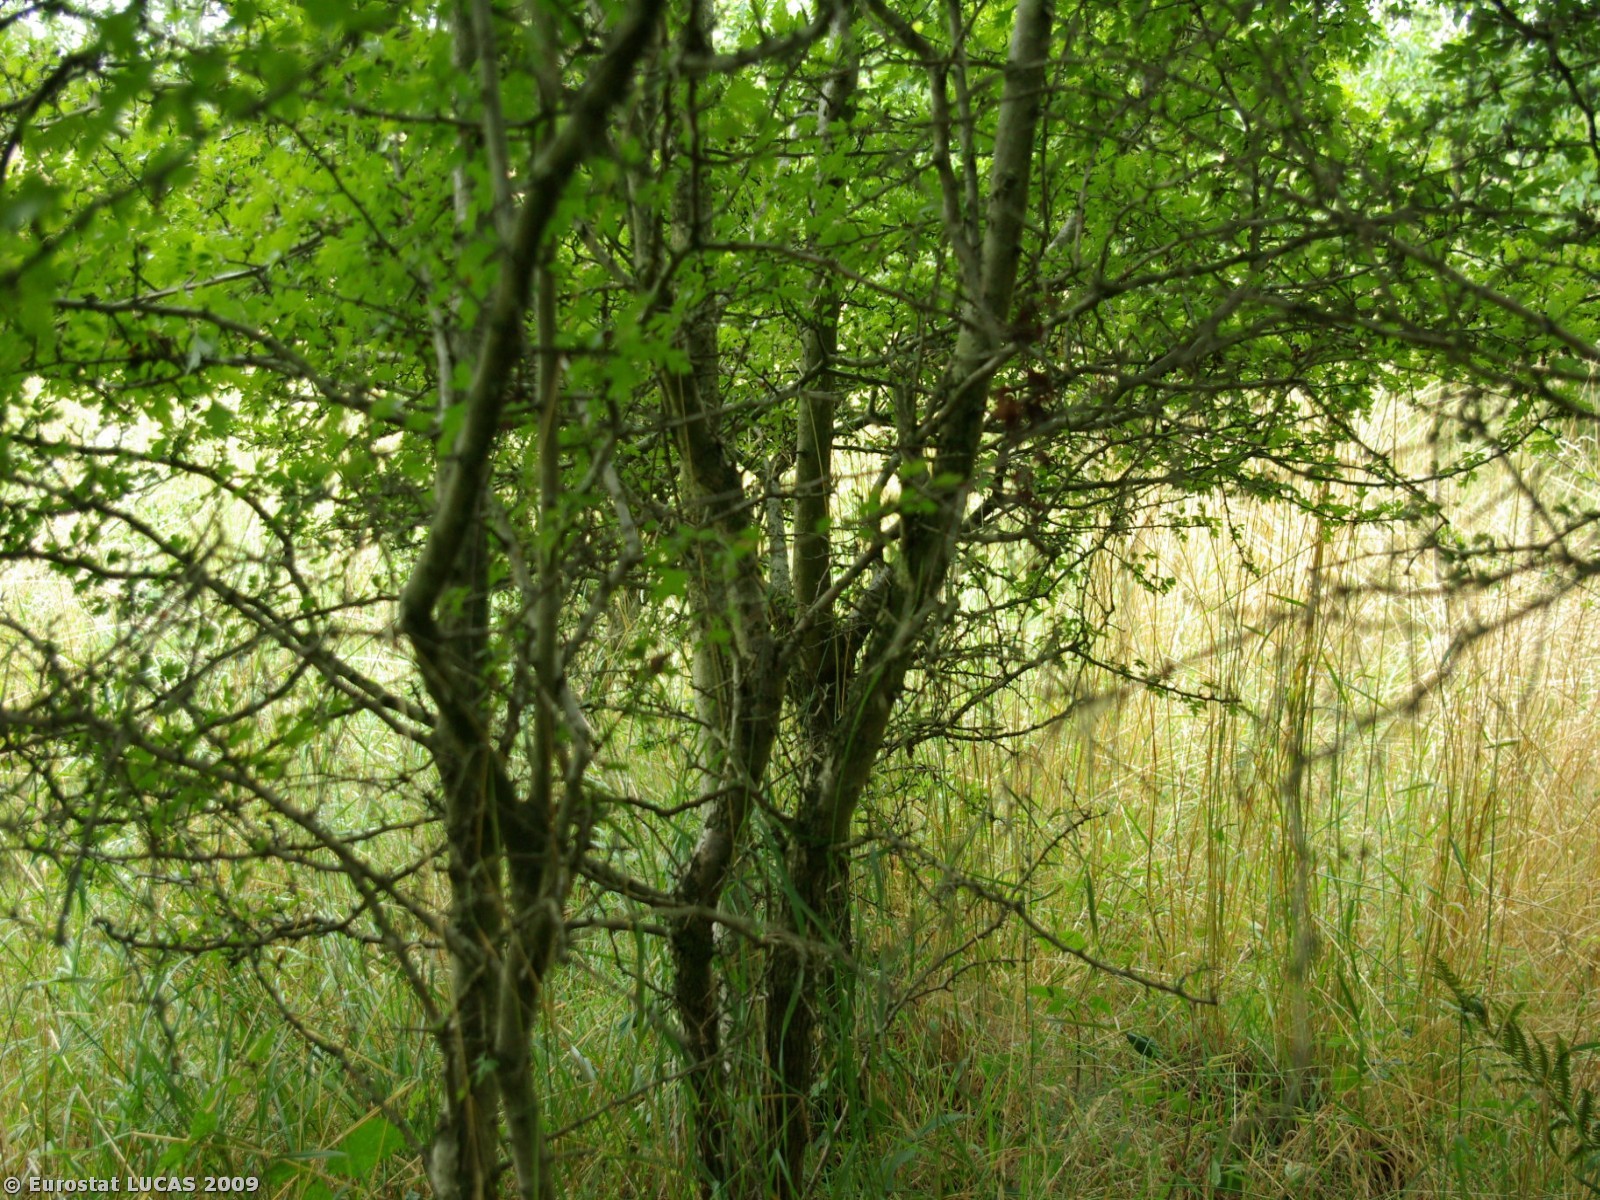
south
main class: Woodland
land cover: Broadleaved woodland
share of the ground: 50 - 75 %
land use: Unused
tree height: > 5 m
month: July
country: DK
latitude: 55.2331
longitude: 9.2930
